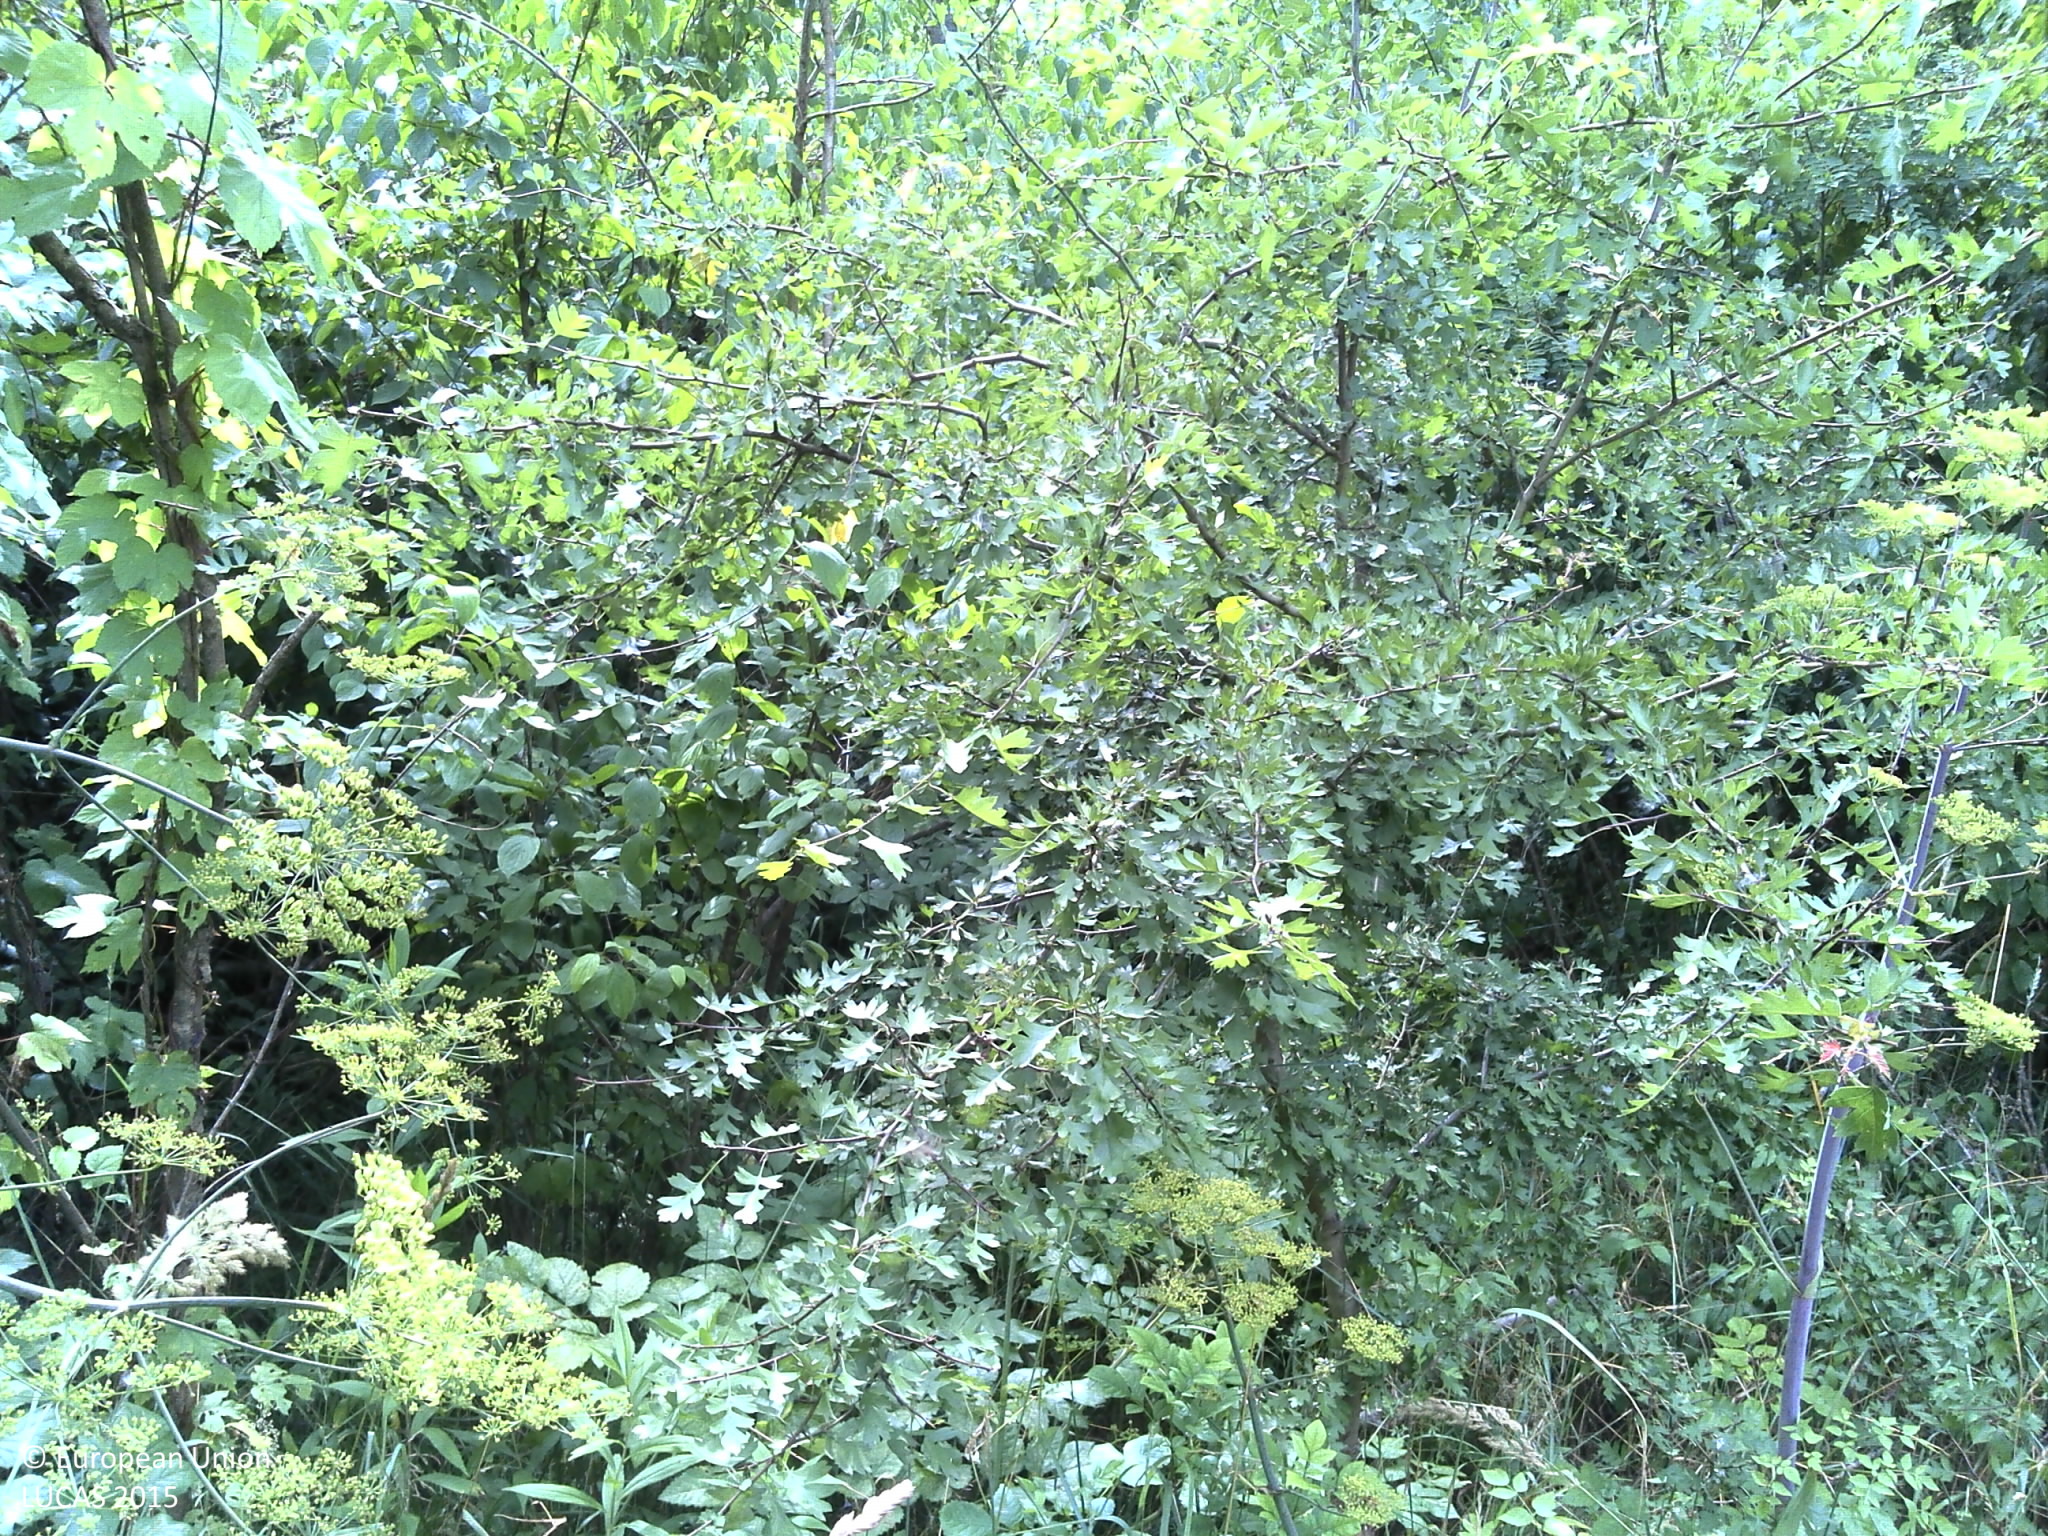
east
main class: Shrubland
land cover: Shrubland with sparse tree cover
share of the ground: > 75 %
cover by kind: shrubs 95 %, broadleaved forest trees 5 %
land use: Forestry
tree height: > 5 m
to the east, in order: Shrubland with sparse tree cover; Broadleaved woodland
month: June
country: HR
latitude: 45.9557
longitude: 17.3179
